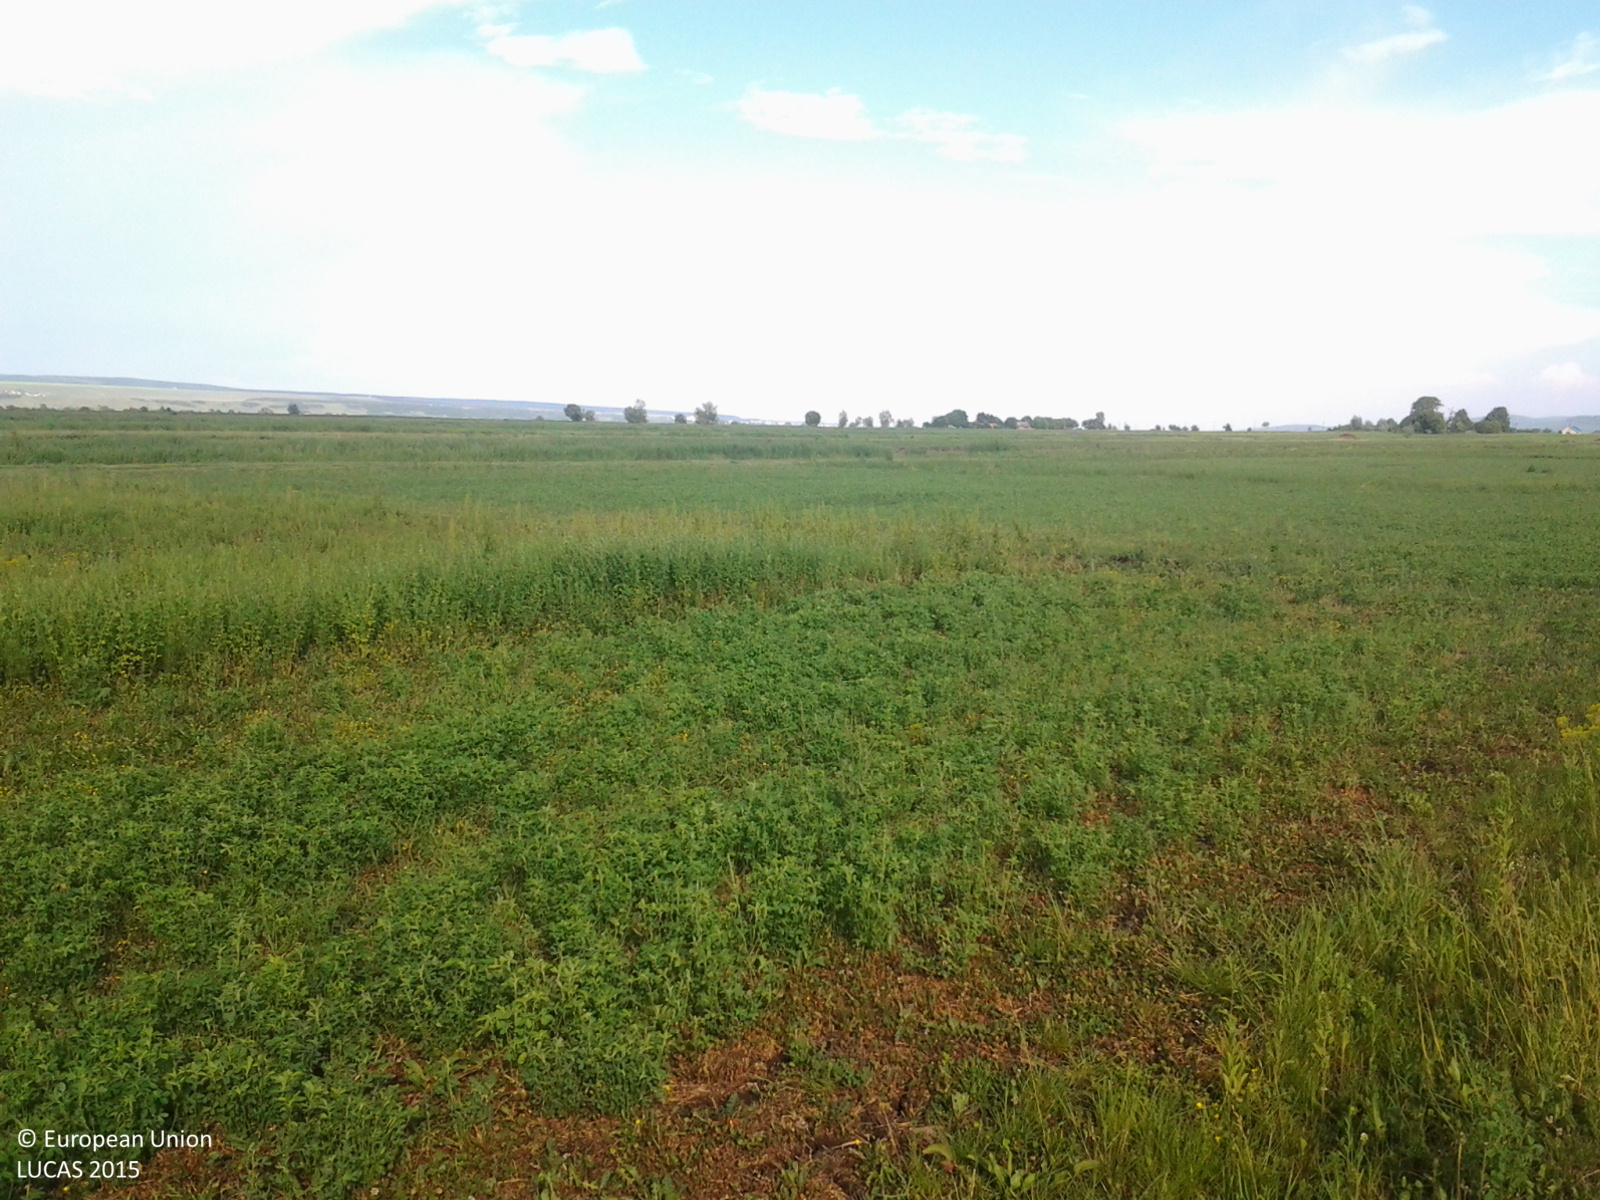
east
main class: Cropland
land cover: Lucerne
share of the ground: > 75 %
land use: Agriculture (excluding fallow land and kitchen gardens)
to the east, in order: Tracks; Lucerne; Other leguminous and mixtures for fodder; Lucerne; Other leguminous and mixtures for fodder; Maize; Other leguminous and mixtures for fodder; Lucerne; Maize; Lucerne; Maize; Lucerne
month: June
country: RO
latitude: 46.7346
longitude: 26.5883
